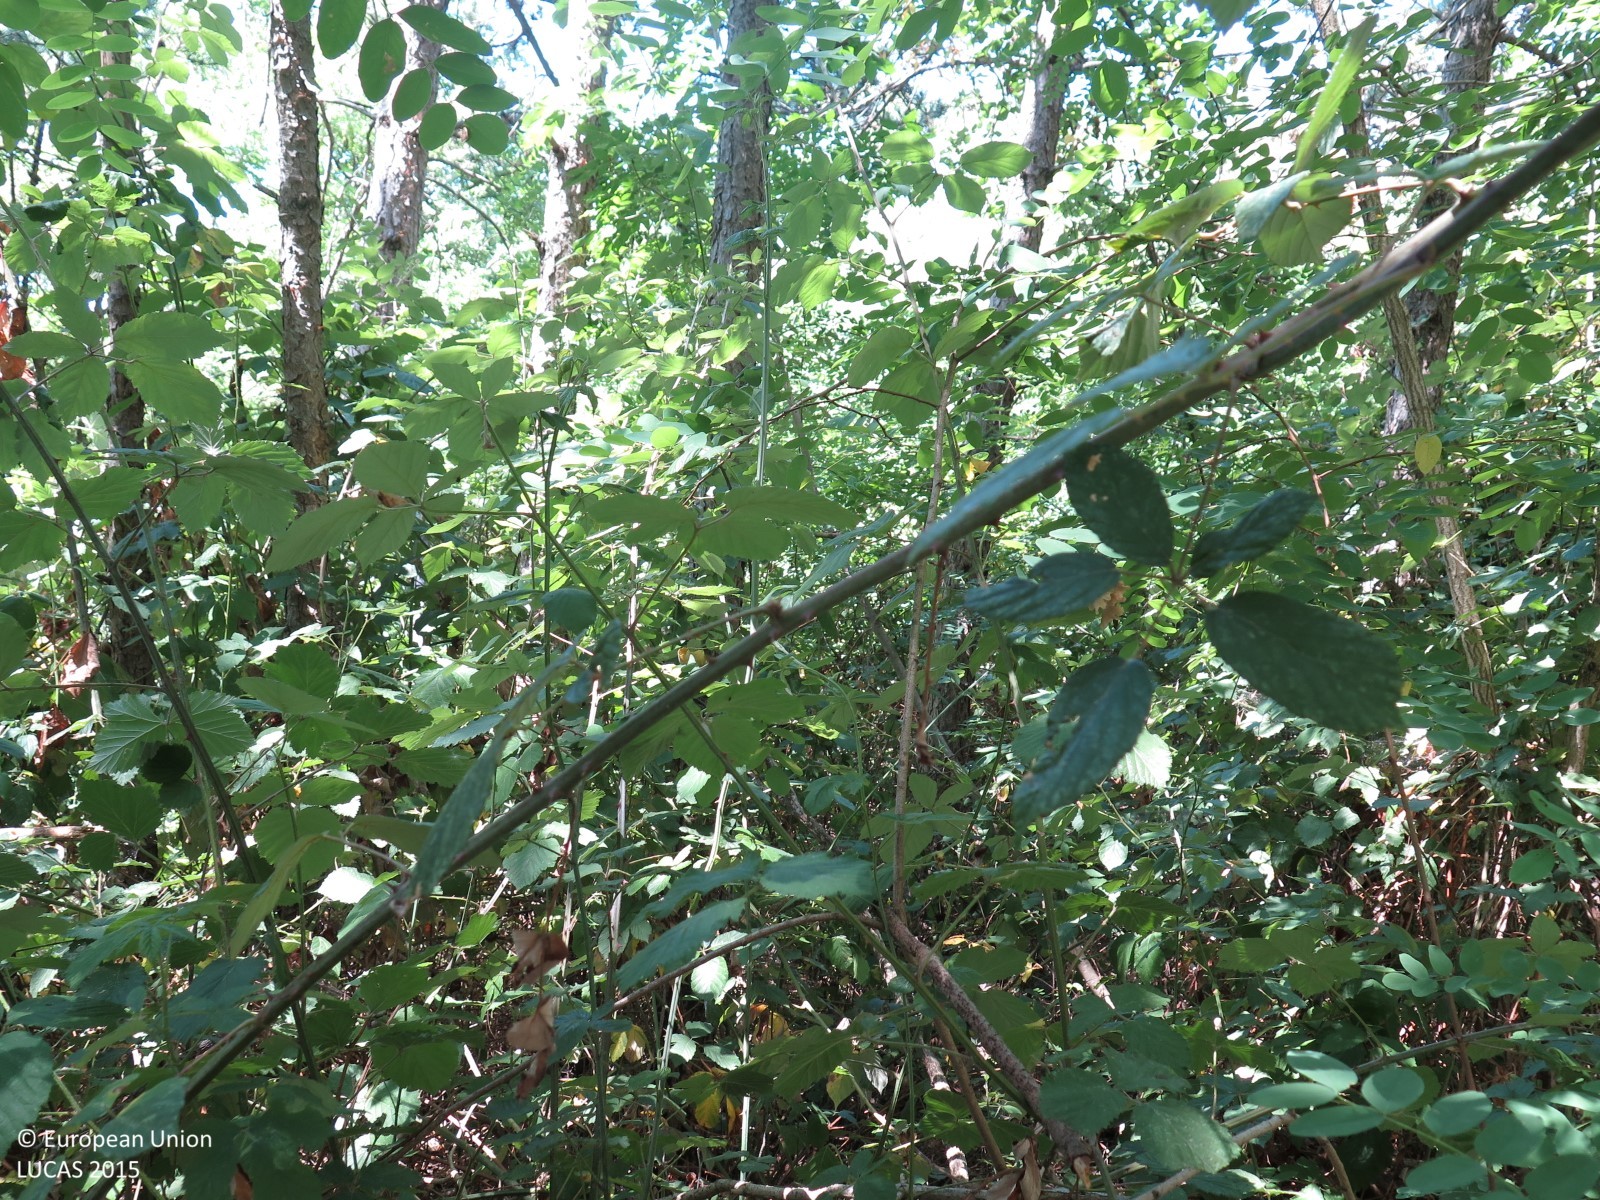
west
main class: Woodland
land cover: Pine dominated mixed woodland
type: coniferous forest of the mediterranean region
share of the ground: > 75 %
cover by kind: coniferous forest trees 75 %, broadleaved forest trees 25 %
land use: Semi-natural and natural areas not in use
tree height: > 5 m
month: July
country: HR
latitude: 45.3976
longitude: 13.8658
